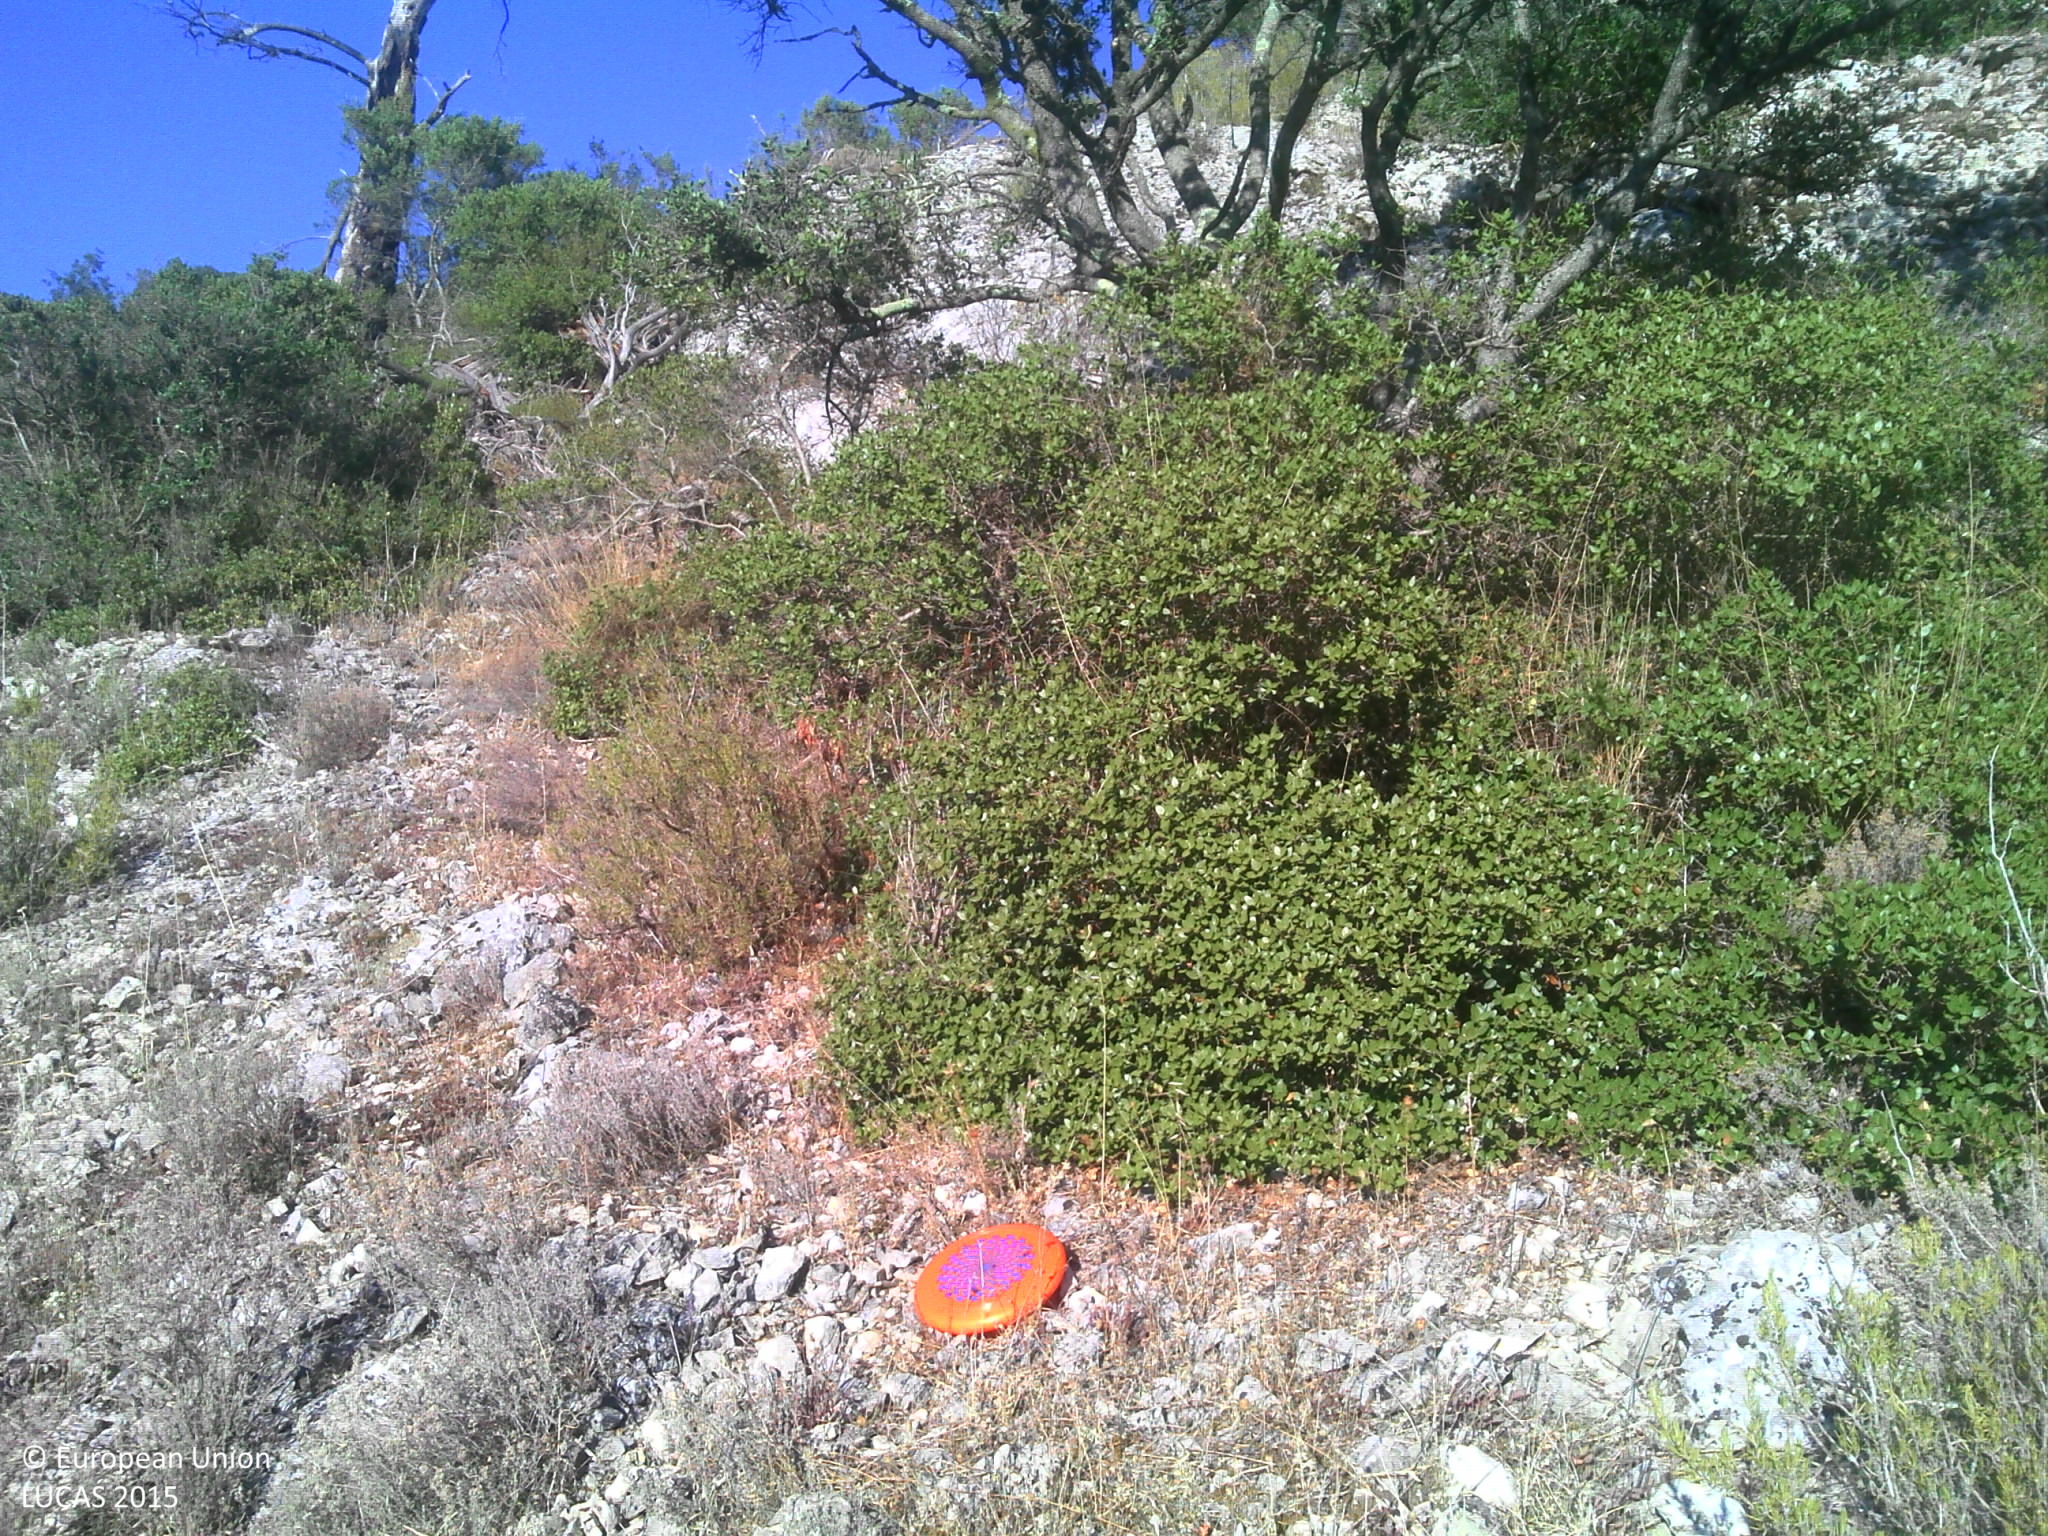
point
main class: Woodland
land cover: Pine dominated coniferous woodland
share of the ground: 50 - 75 %
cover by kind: coniferous forest trees 35 %, shrubs 30 %, herbaceous plants 15 %, unconsolidated bare surface 15 %, broadleaved forest trees 5 %
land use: Forestry
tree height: < 5 m
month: August
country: FR
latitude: 43.2703
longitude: 5.7594
